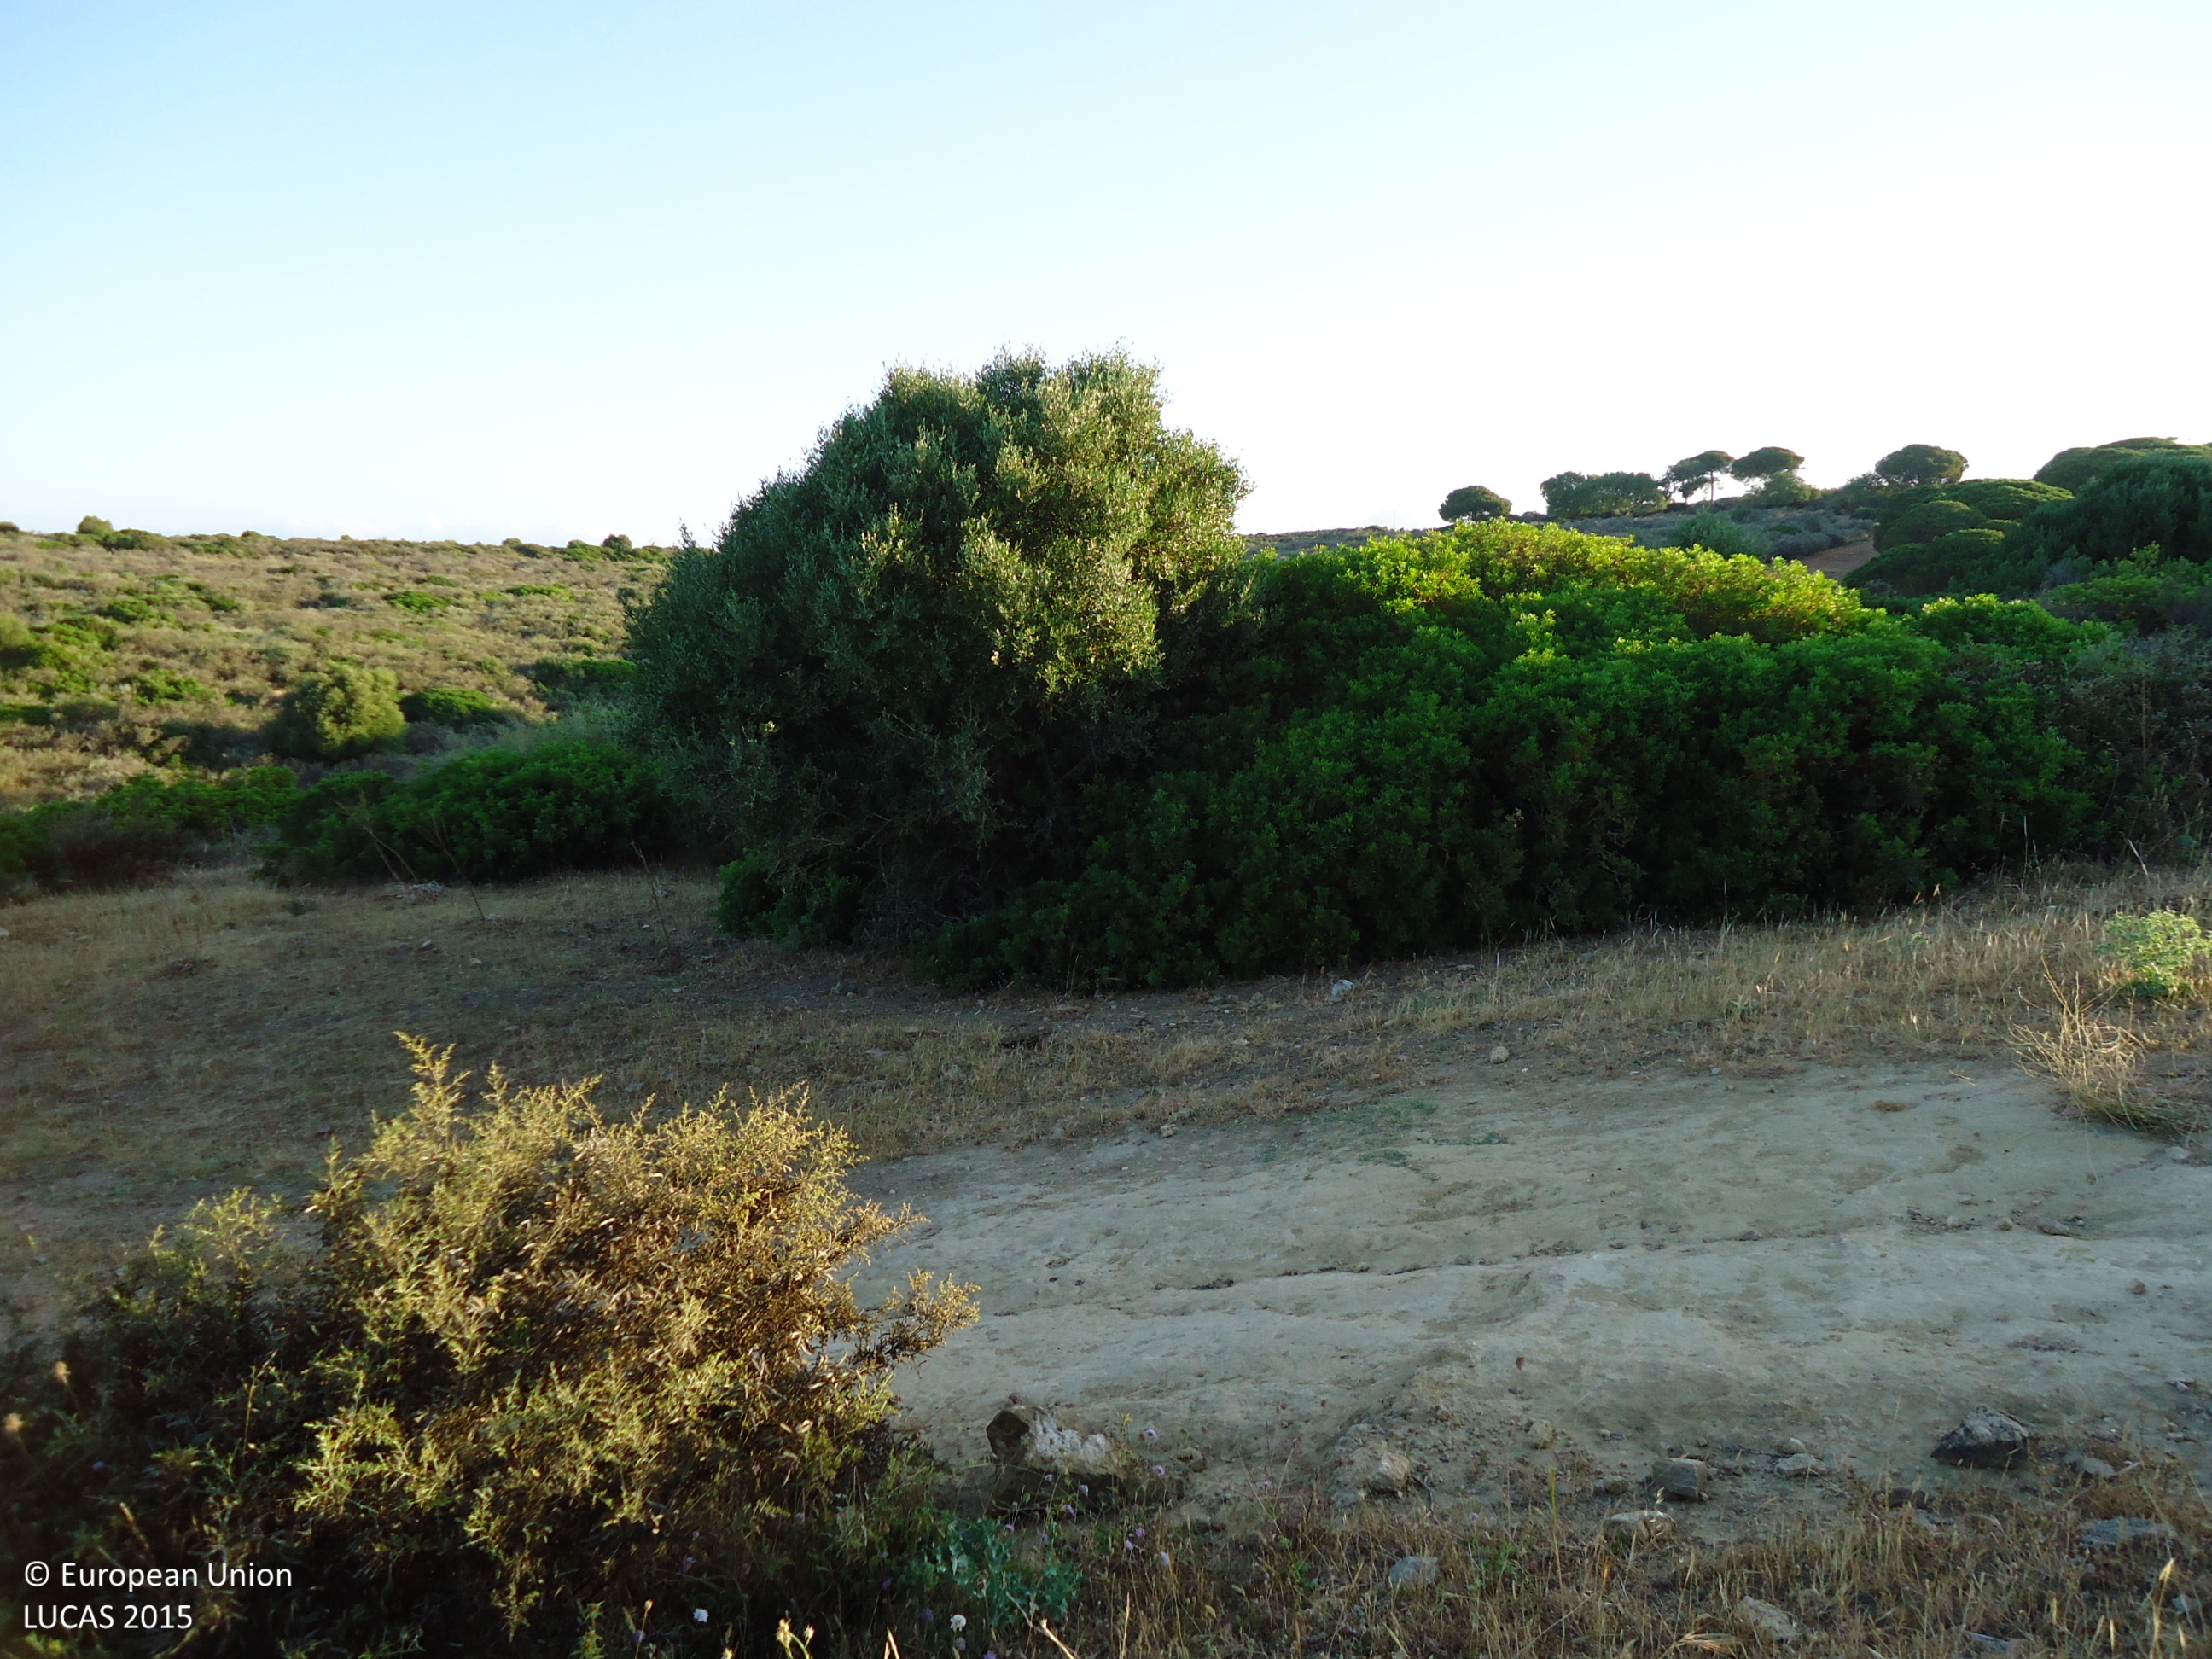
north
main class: Shrubland
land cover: Shrubland without tree cover
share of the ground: 25 - 50 %
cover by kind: herbaceous plants 60 %, shrubs 40 %
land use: Agriculture (excluding fallow land and kitchen gardens)
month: June
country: ES
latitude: 36.3373
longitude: -5.2898
